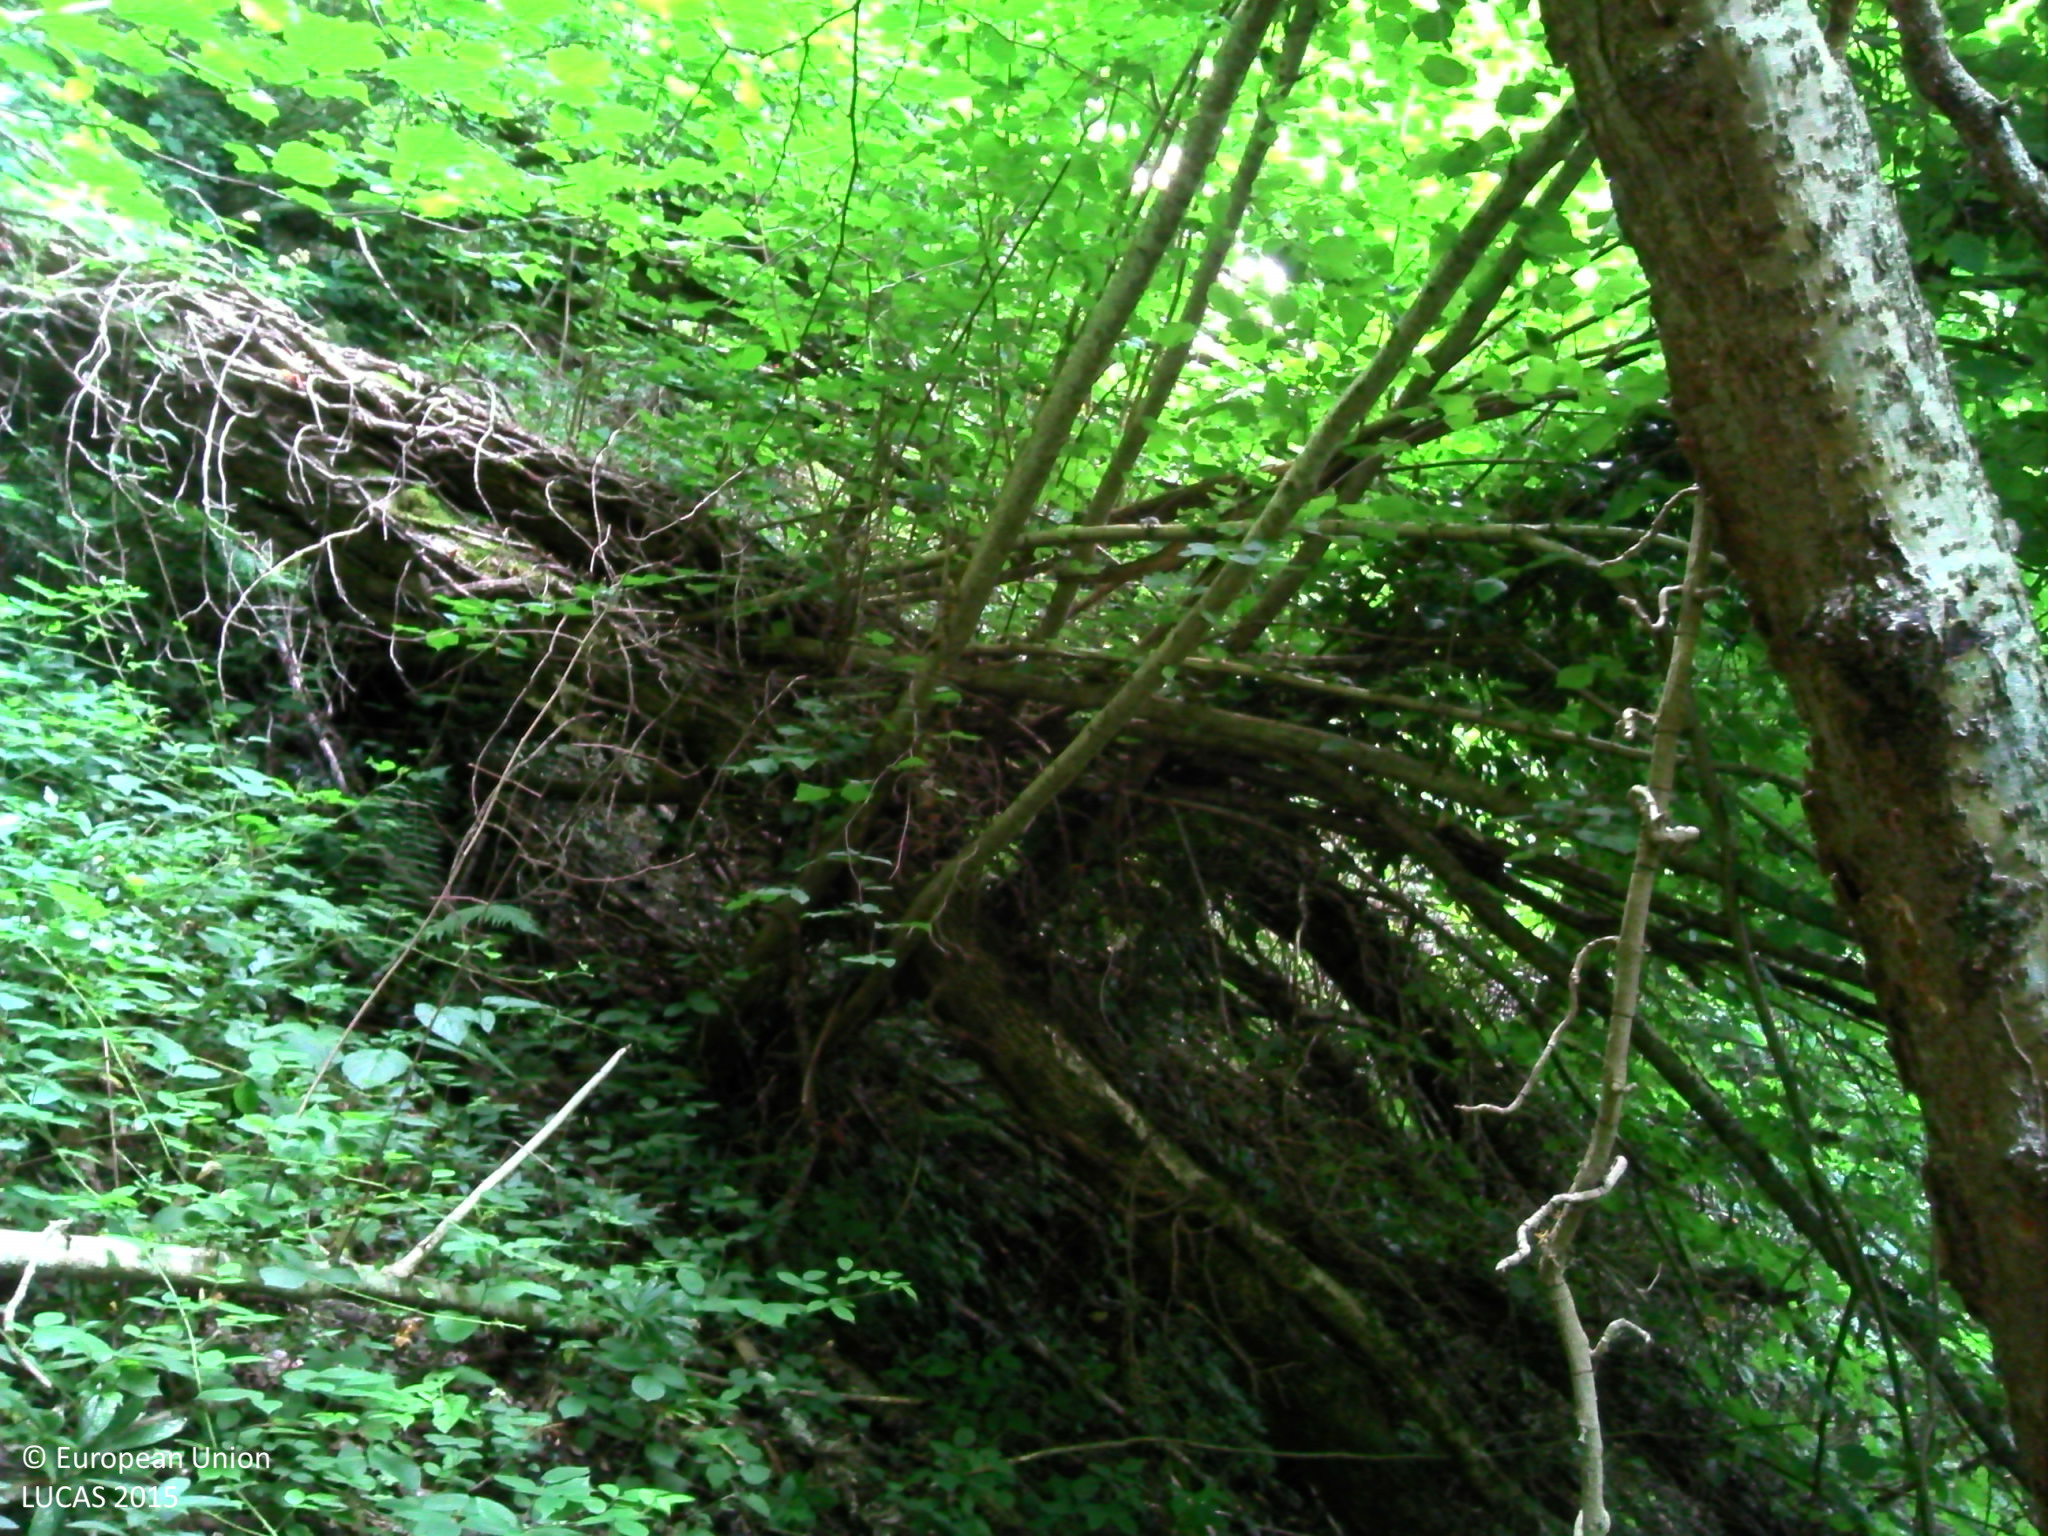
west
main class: Woodland
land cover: Broadleaved woodland
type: mesophytic deciduous forest
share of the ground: > 75 %
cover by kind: broadleaved forest trees 90 %, shrubs 5 %, herbaceous plants 5 %
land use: Forestry
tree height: > 5 m
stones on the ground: 10 - 25 %
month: July
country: FR
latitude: 42.9823
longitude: -0.1198
